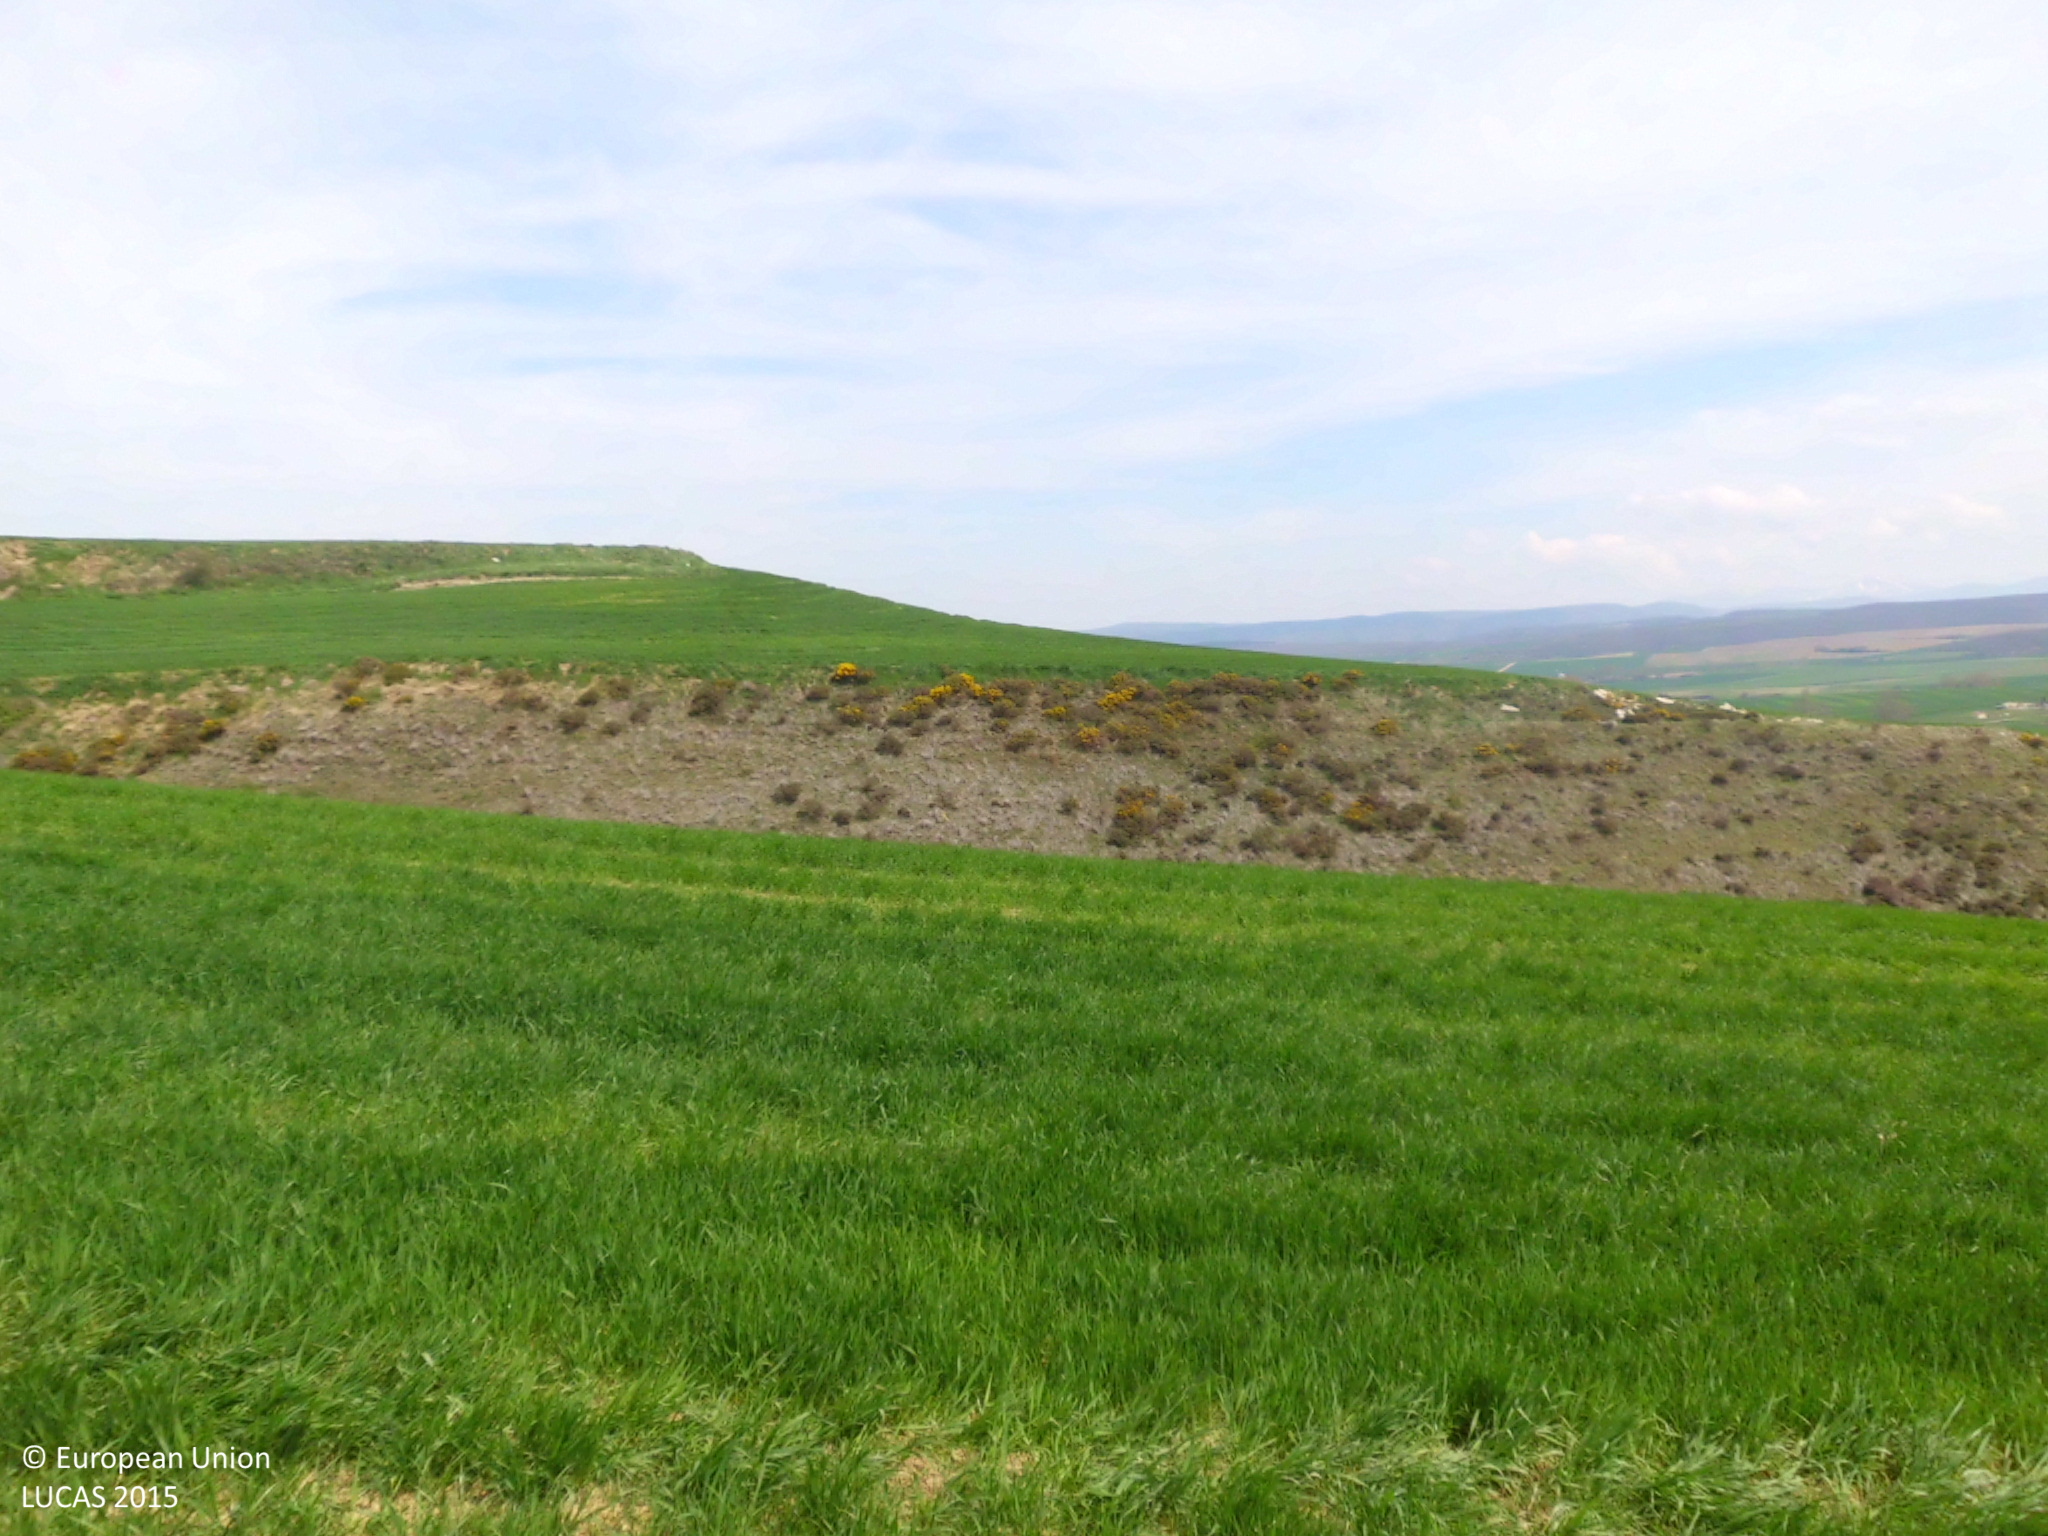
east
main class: Cropland
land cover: Barley
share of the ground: > 75 %
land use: Agriculture (excluding fallow land and kitchen gardens)
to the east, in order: Barley; Grassland without tree/shrub cover; Barley; Grassland without tree/shrub cover; Barley
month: April
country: ES
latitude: 42.4138
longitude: -3.2886
